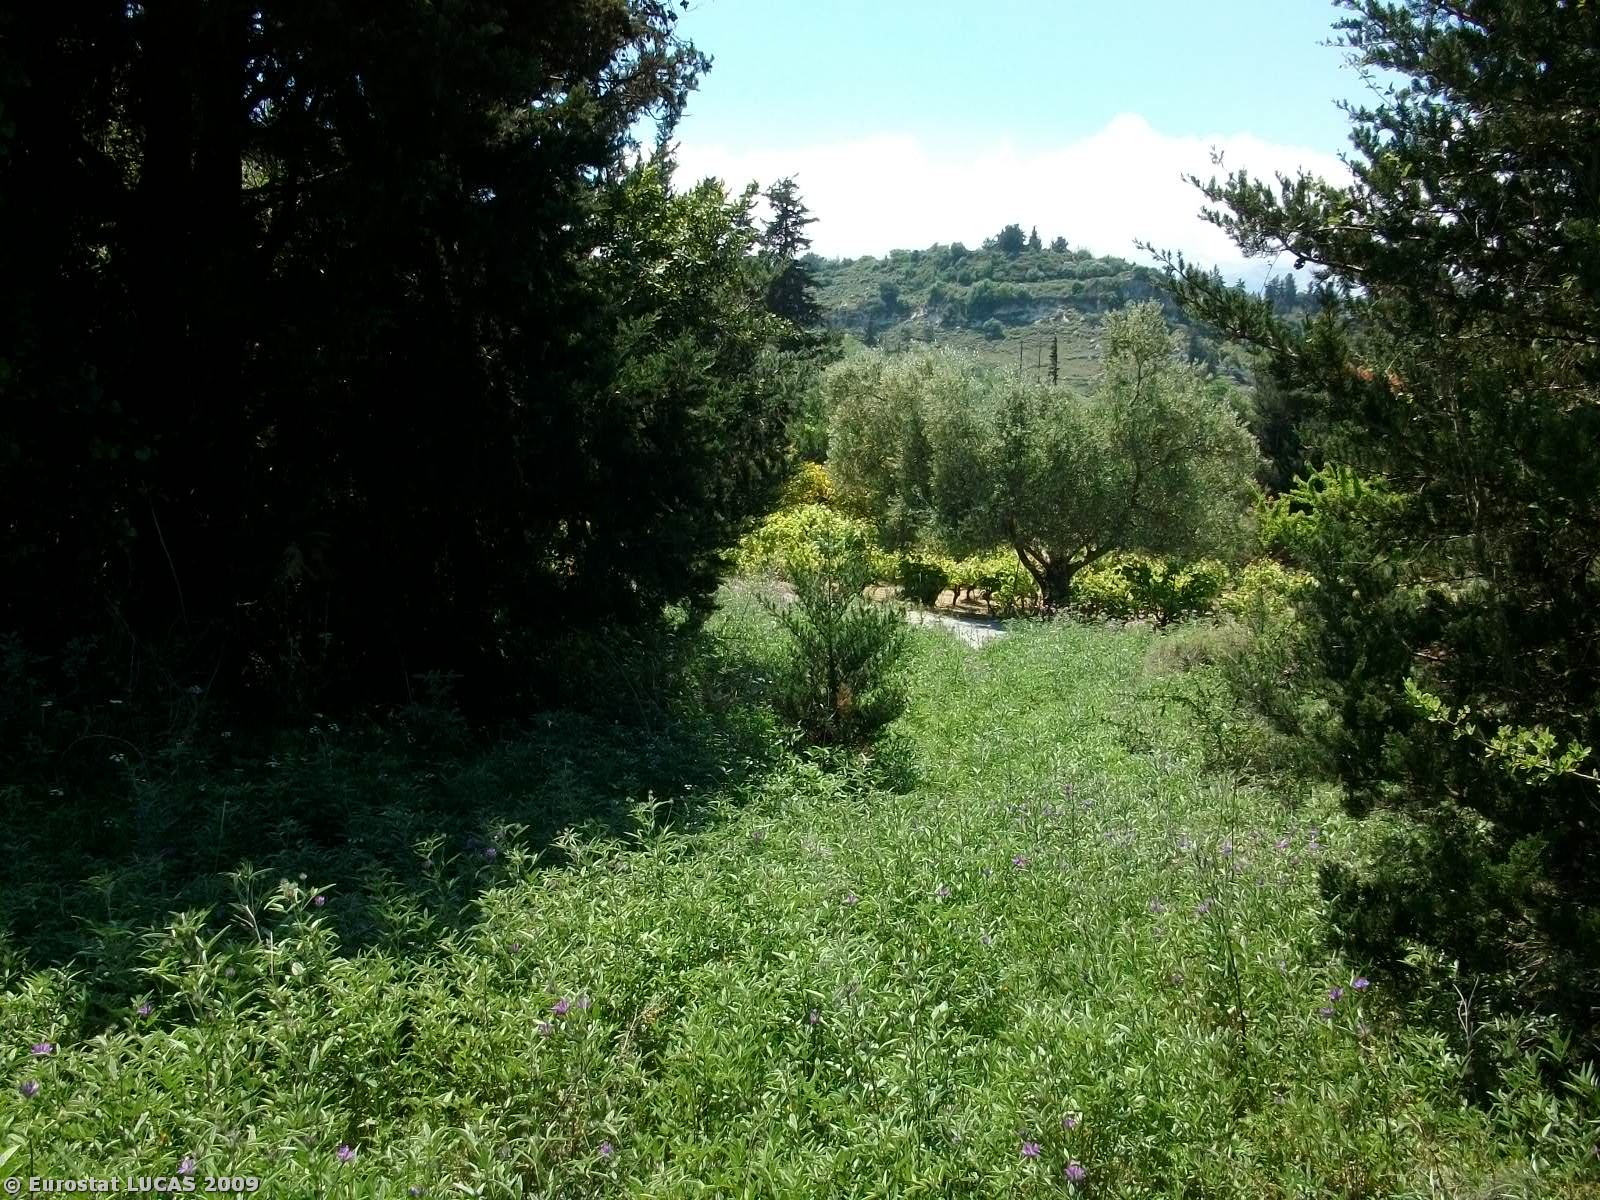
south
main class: Woodland
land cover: Mixed woodland
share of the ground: 25 - 50 %
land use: Forestry
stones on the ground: < 10 %
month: May
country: GR
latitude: 35.3673
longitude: 24.2159
